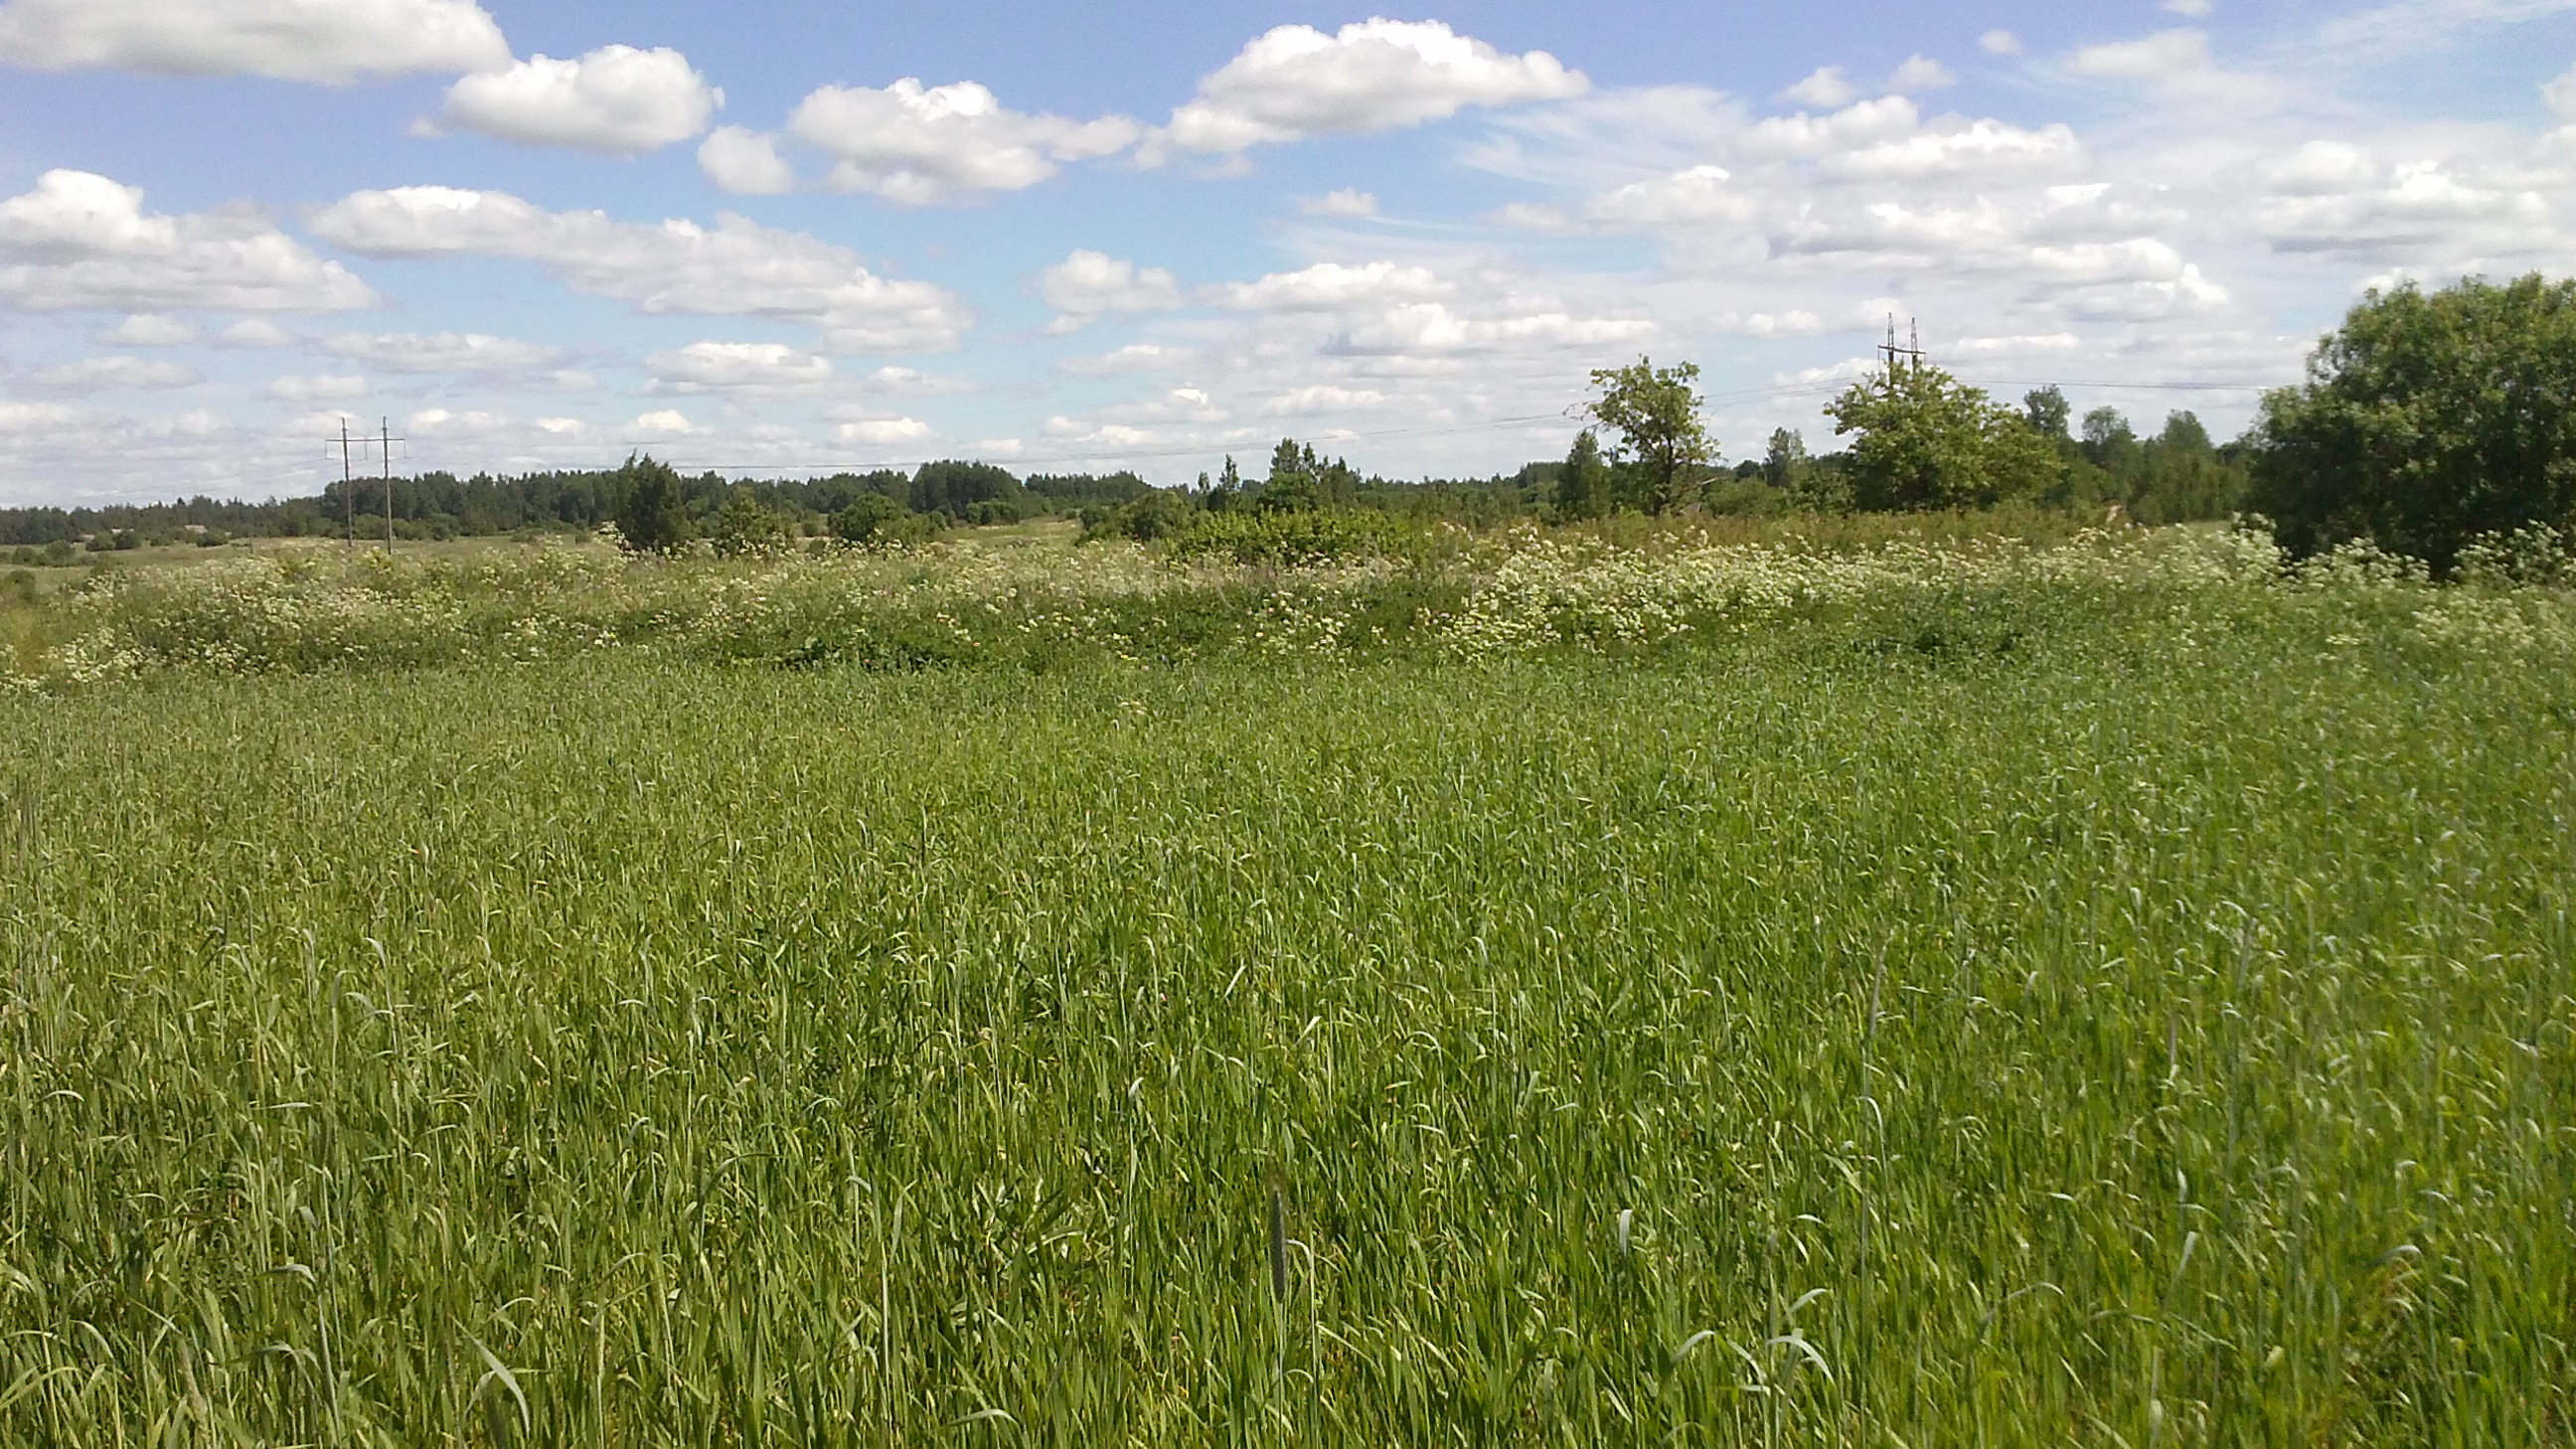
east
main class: Cropland
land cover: Common wheat
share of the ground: > 75 %
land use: Agriculture (excluding fallow land and kitchen gardens)
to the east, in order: Common wheat; Spontaneously vegetated surfaces; Tracks; Spontaneously vegetated surfaces; Shrubland without tree cover; Spontaneously vegetated surfaces
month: June
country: LV
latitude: 56.4484
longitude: 27.2210
